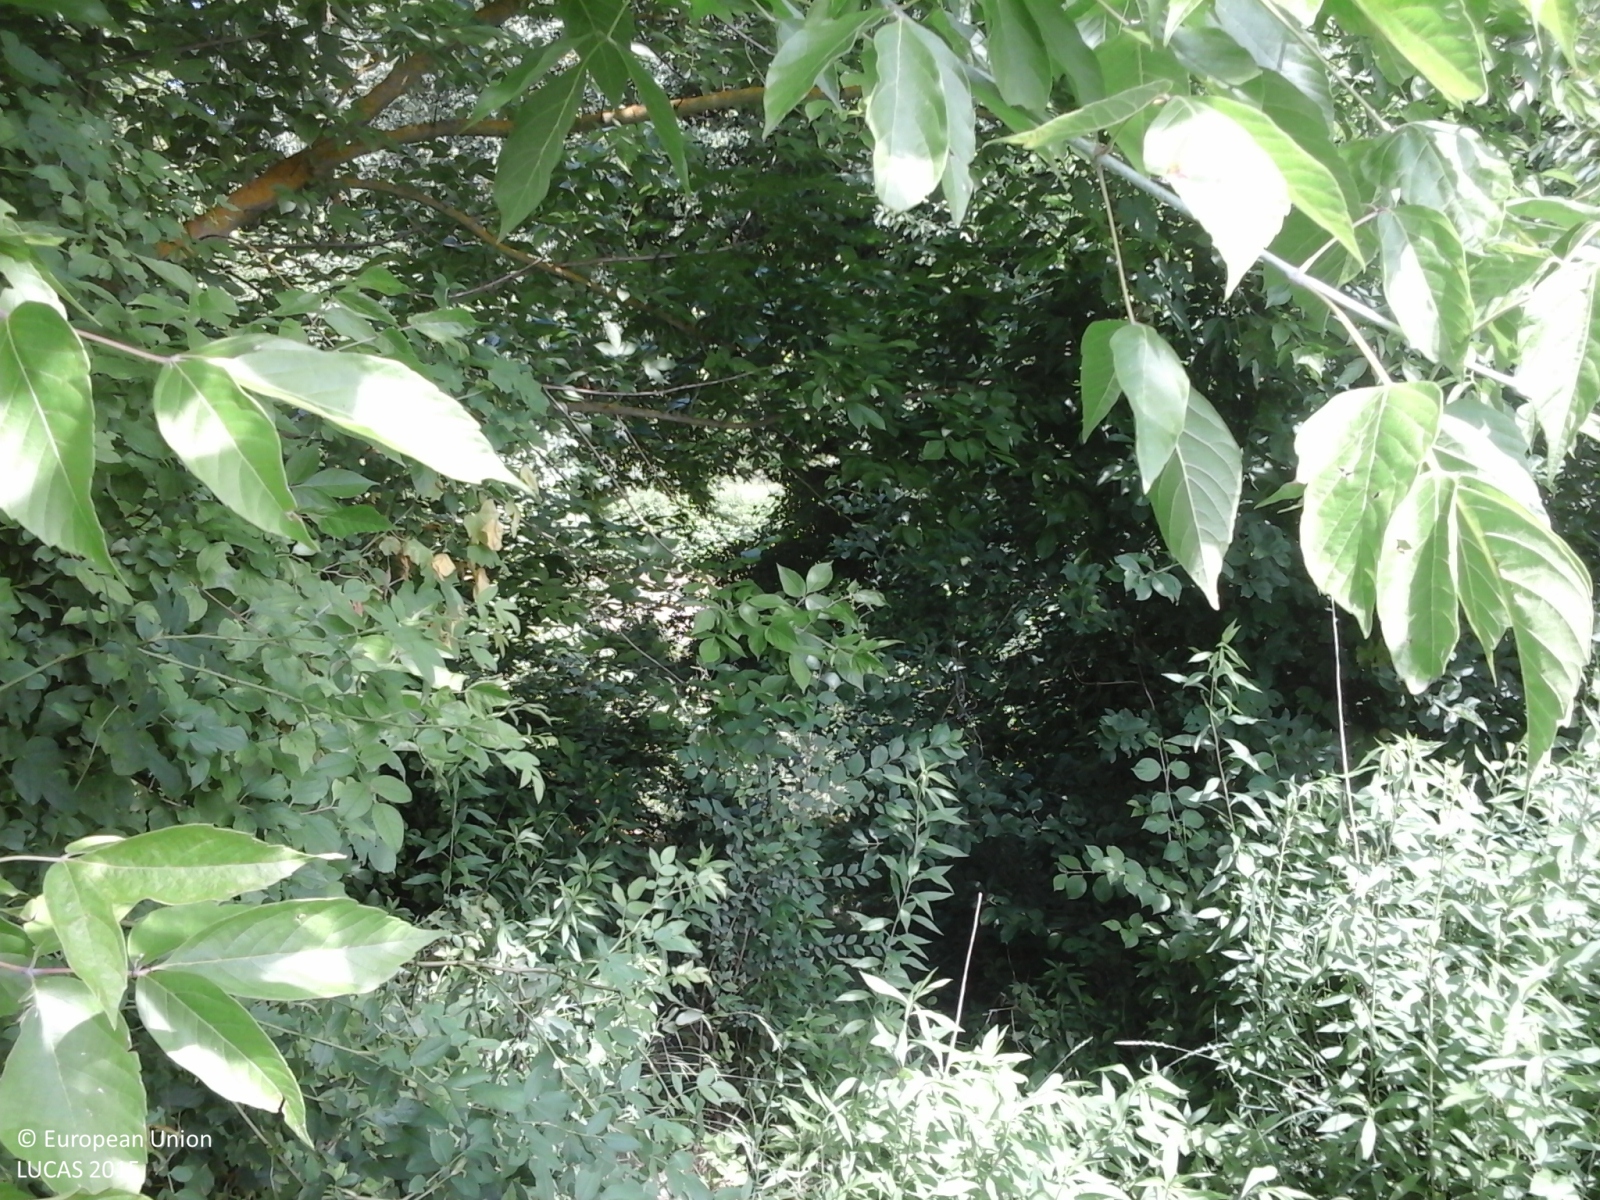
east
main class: Woodland
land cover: Broadleaved woodland
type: thermophilous deciduous forest
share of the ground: > 75 %
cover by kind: broadleaved forest trees 80 %, shrubs 10 %, herbaceous plants 10 %
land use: Semi-natural and natural areas not in use
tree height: > 5 m
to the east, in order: Broadleaved woodland; Grass margins; Tracks; Grass margins; Ditches and canals; Grassland without tree/shrub cover; Broadleaved woodland
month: June
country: IT
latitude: 45.0054
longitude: 8.3918
